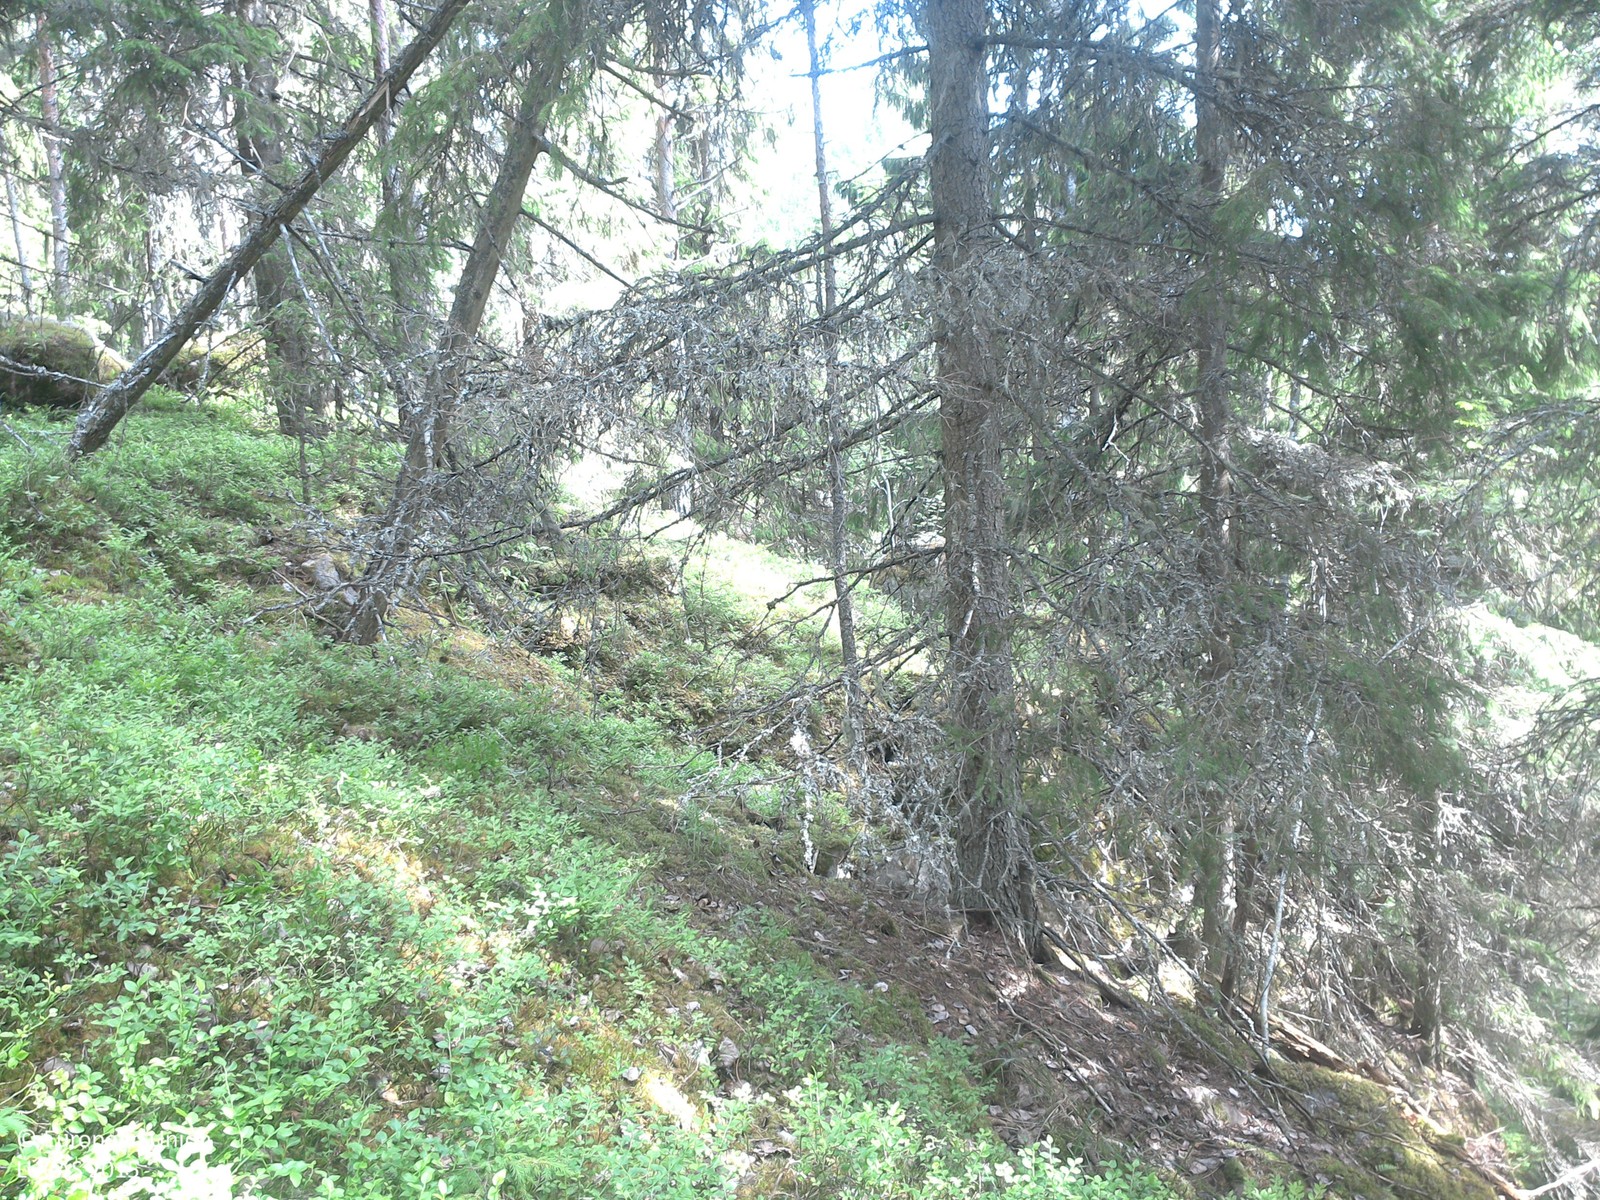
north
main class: Woodland
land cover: Spruce dominated coniferous woodland
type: boreal forest
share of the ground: 50 - 75 %
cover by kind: coniferous forest trees 60 %, lichens and mosses 20 %, herbaceous plants 15 %, broadleaved forest trees 5 %
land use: Forestry
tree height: > 5 m
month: June
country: SE
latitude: 58.1424
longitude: 15.5159
